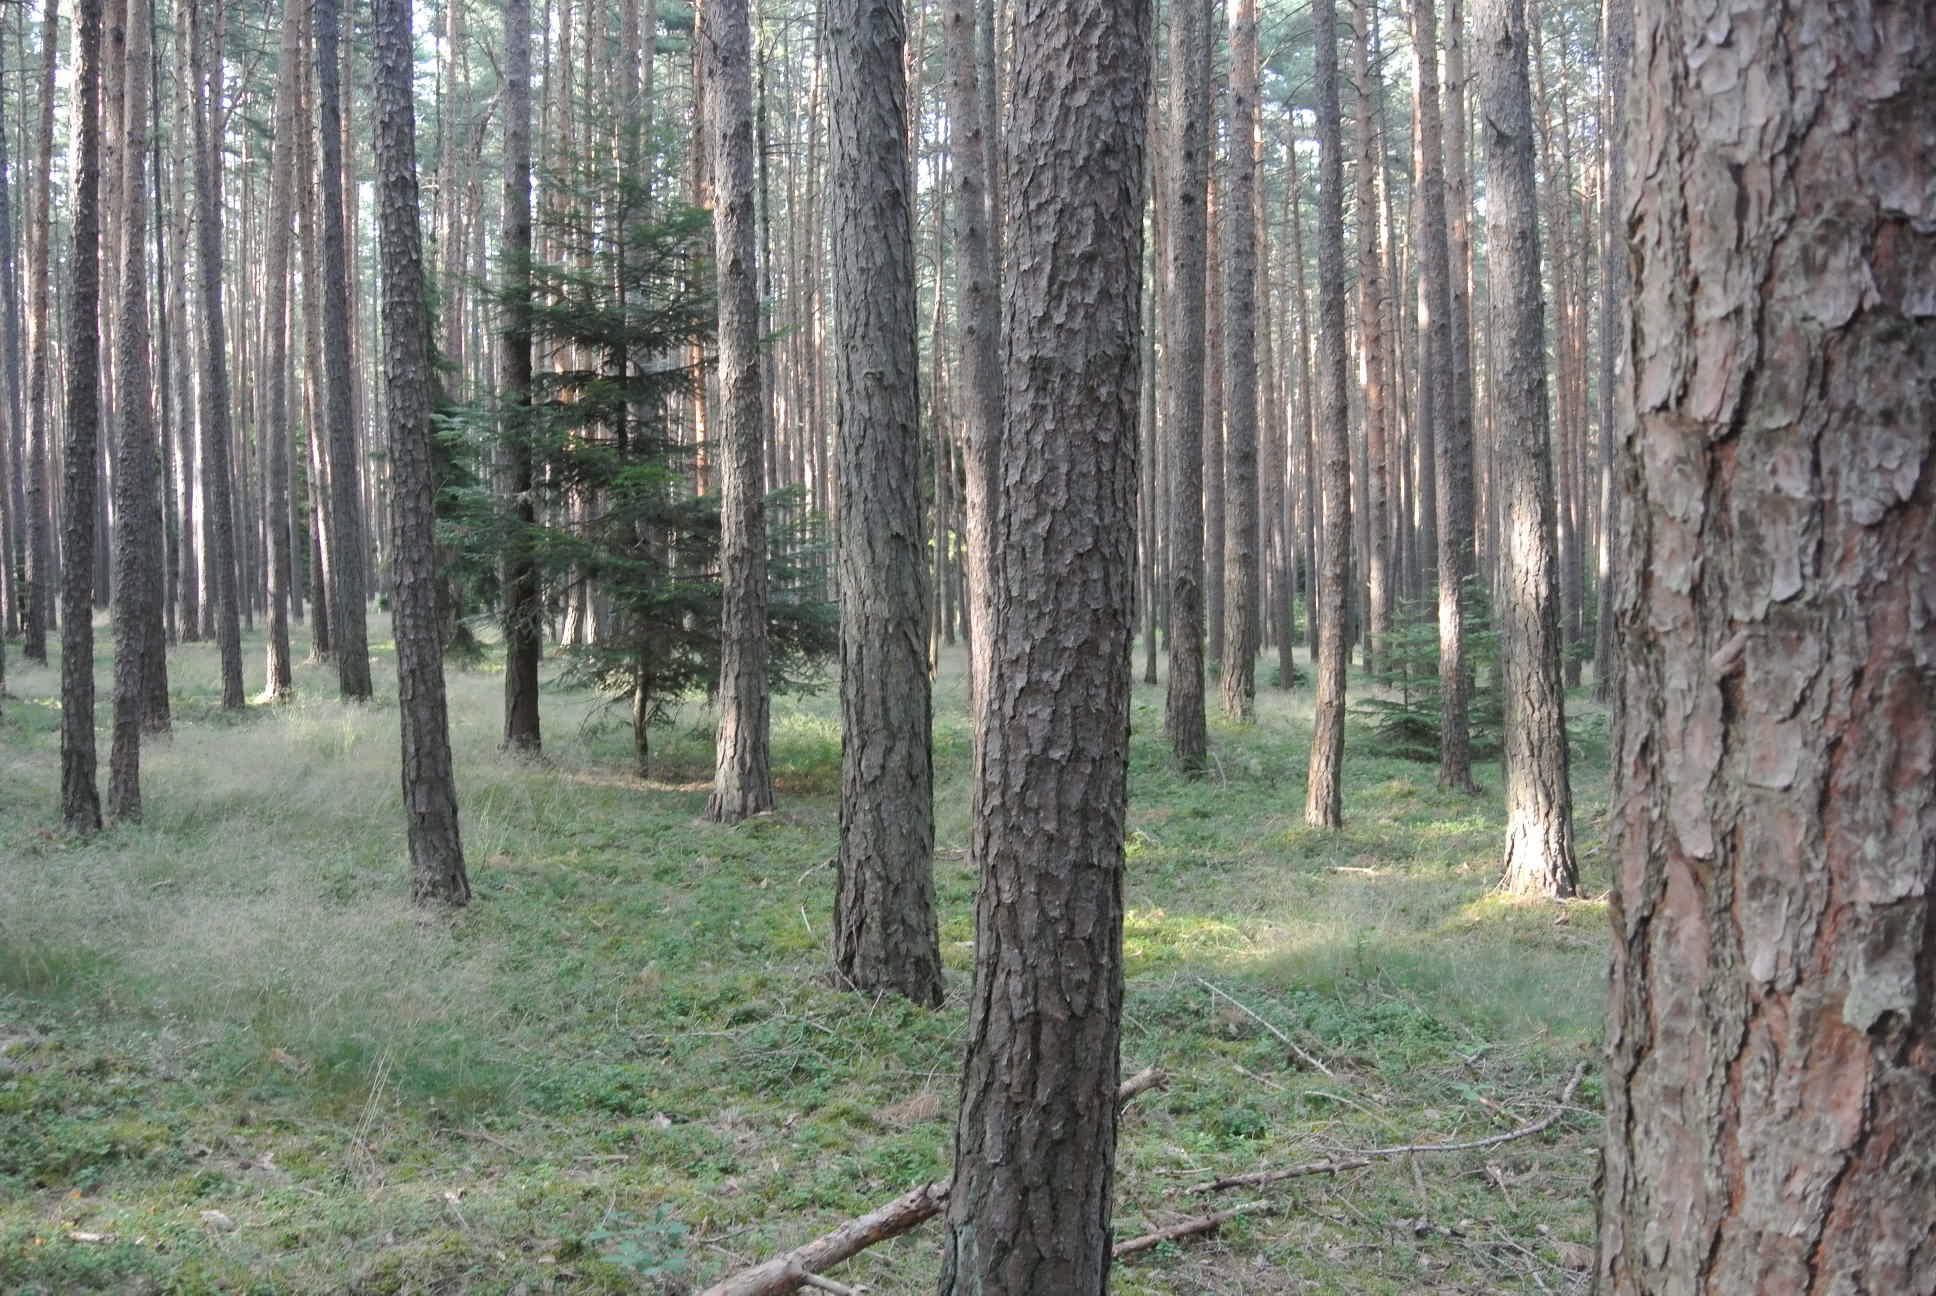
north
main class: Woodland
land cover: Pine dominated coniferous woodland
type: alpine coniferous forest
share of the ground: > 75 %
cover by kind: coniferous forest trees 100 %
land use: Forestry
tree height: > 5 m
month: July
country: AT
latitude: 47.6926
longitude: 16.1187
